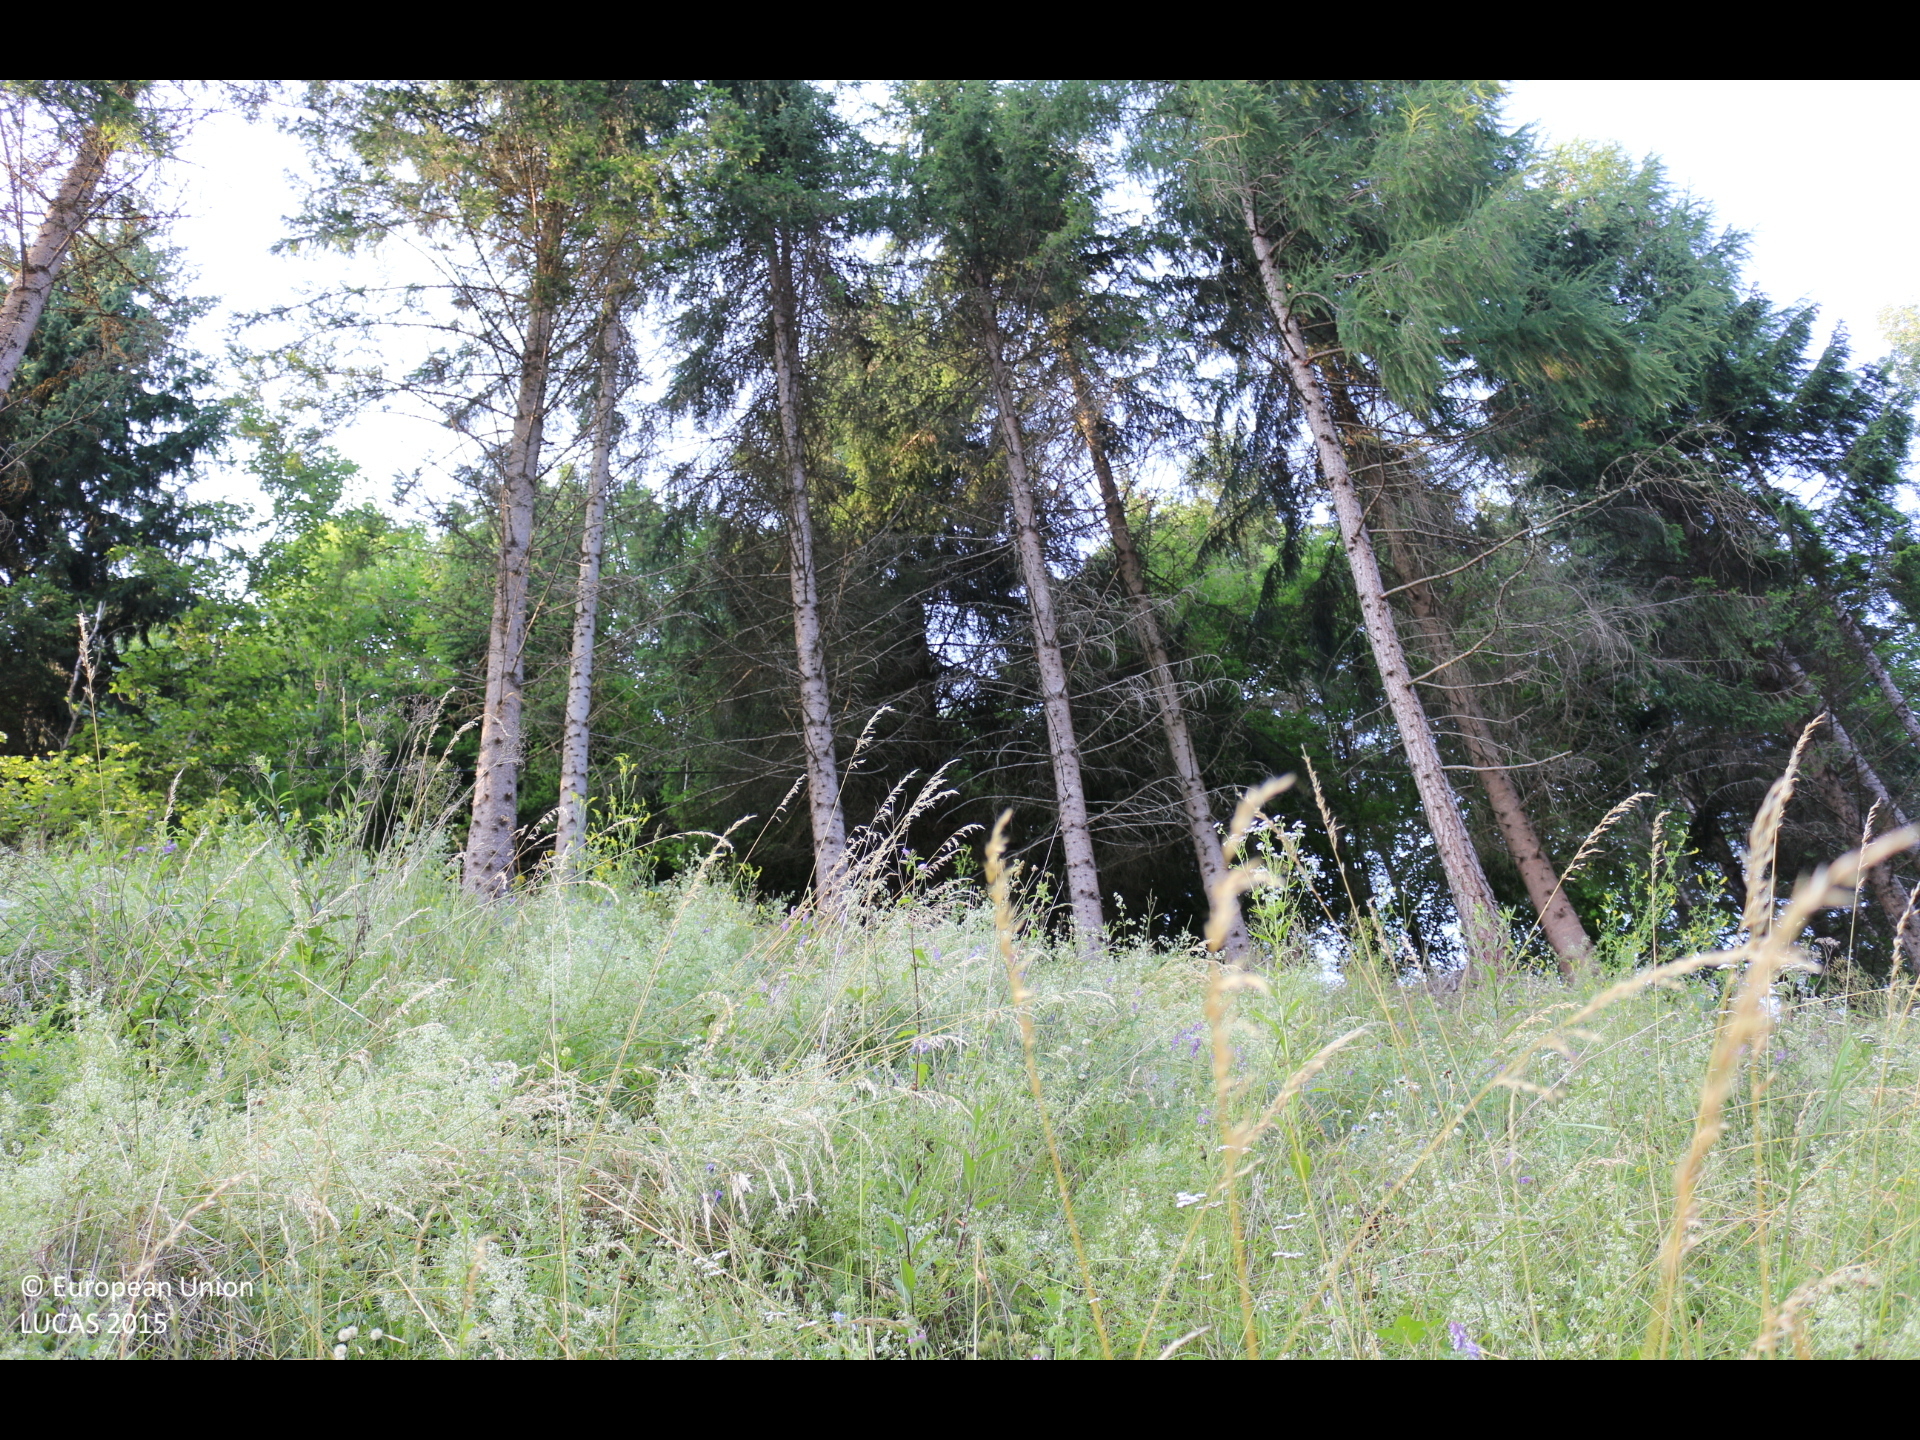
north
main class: Grassland
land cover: Grassland without tree/shrub cover
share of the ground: > 75 %
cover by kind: herbaceous plants 95 %, shrubs 5 %
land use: Road transport
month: July
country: AT
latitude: 46.9193
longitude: 14.6074
